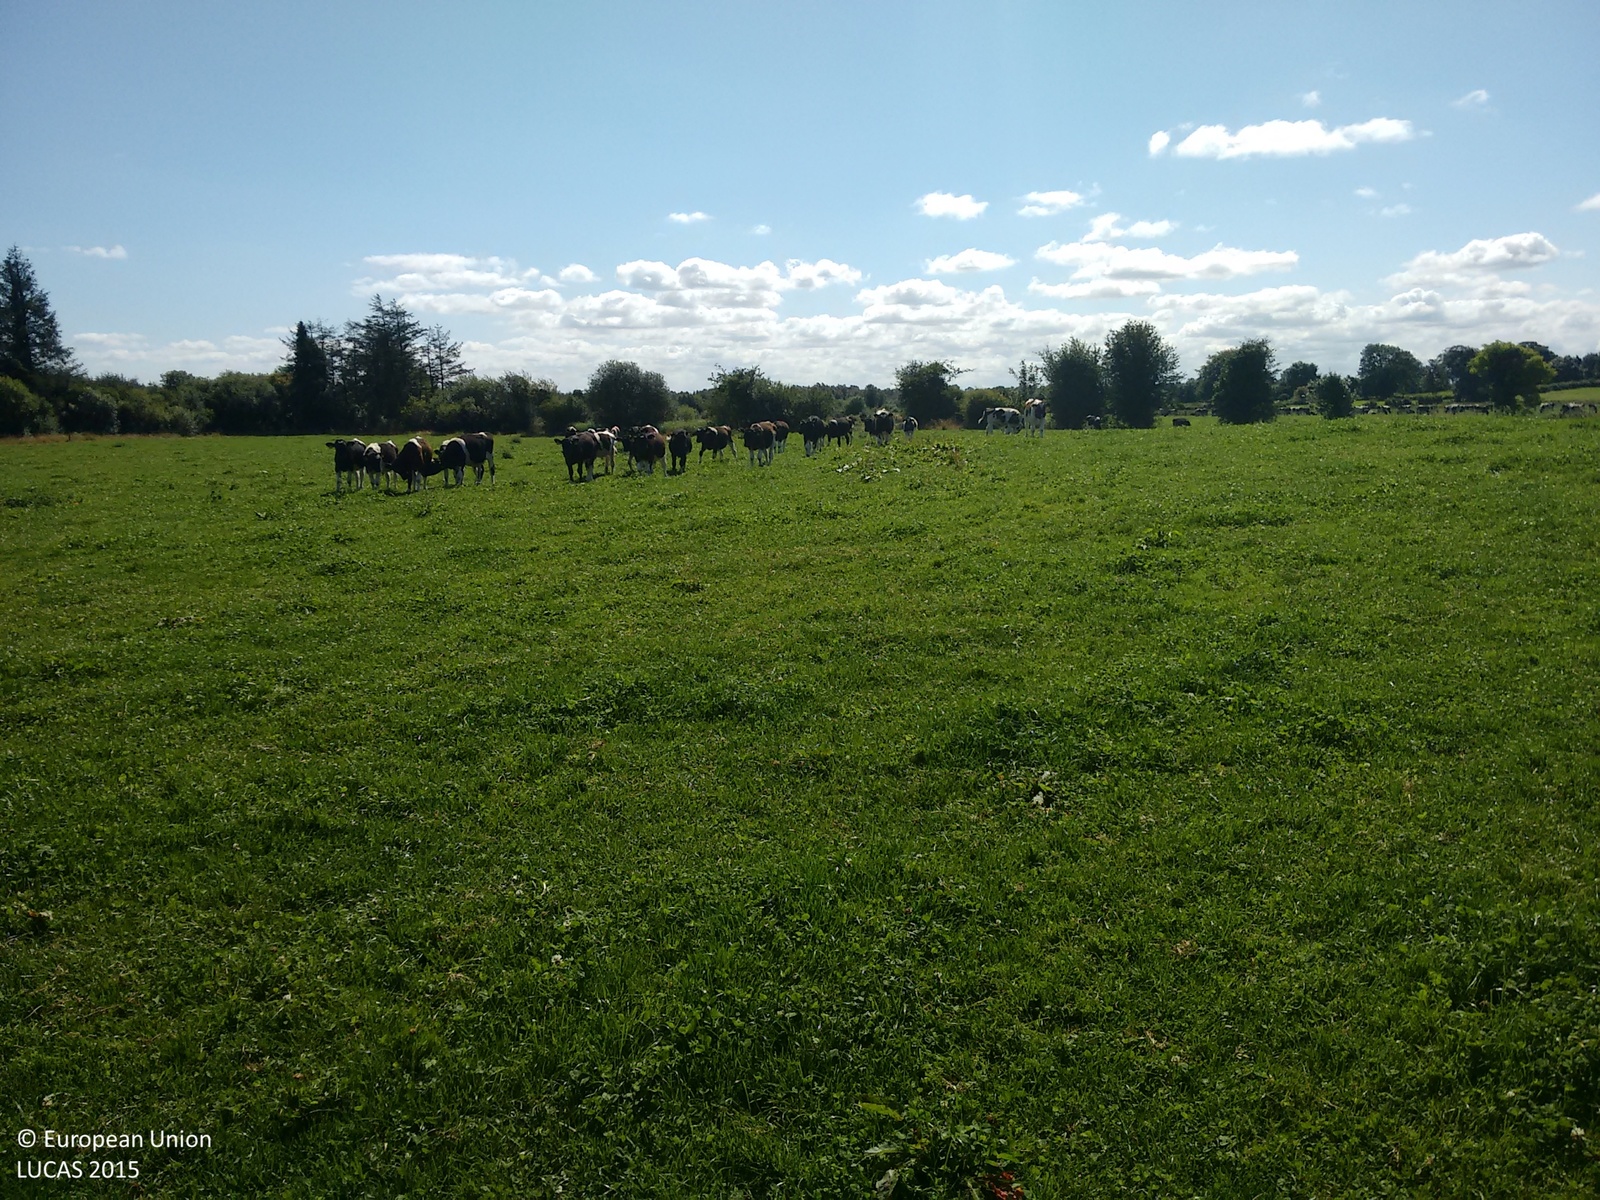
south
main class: Grassland
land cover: Grassland without tree/shrub cover
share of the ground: > 75 %
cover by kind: herbaceous plants 100 %
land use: Agriculture (excluding fallow land and kitchen gardens)
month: August
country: IE
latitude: 52.9124
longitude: -7.6976
